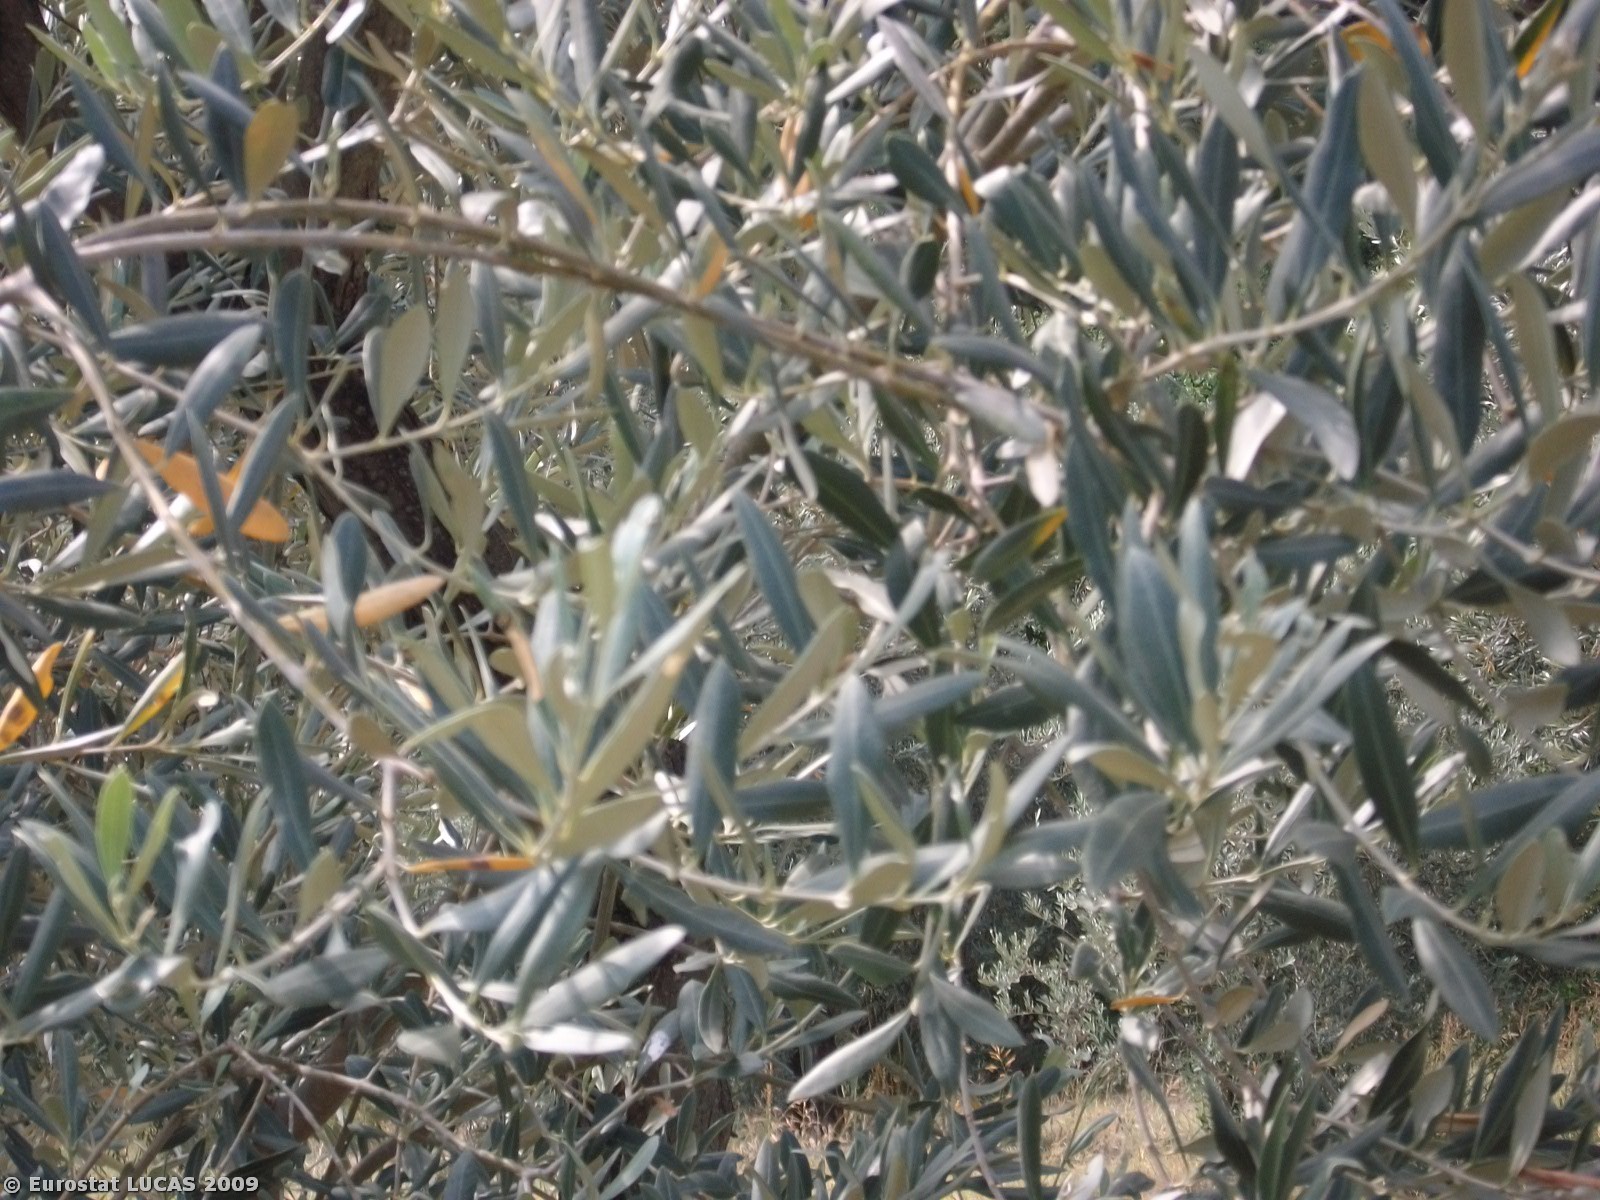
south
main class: Cropland
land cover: Olive groves
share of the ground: 25 - 50 %
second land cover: Grassland with sparse tree/shrub cover
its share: > 75 %
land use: Agriculture (excluding fallow land and kitchen gardens)
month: August
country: GR
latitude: 38.7645
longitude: 22.6751
